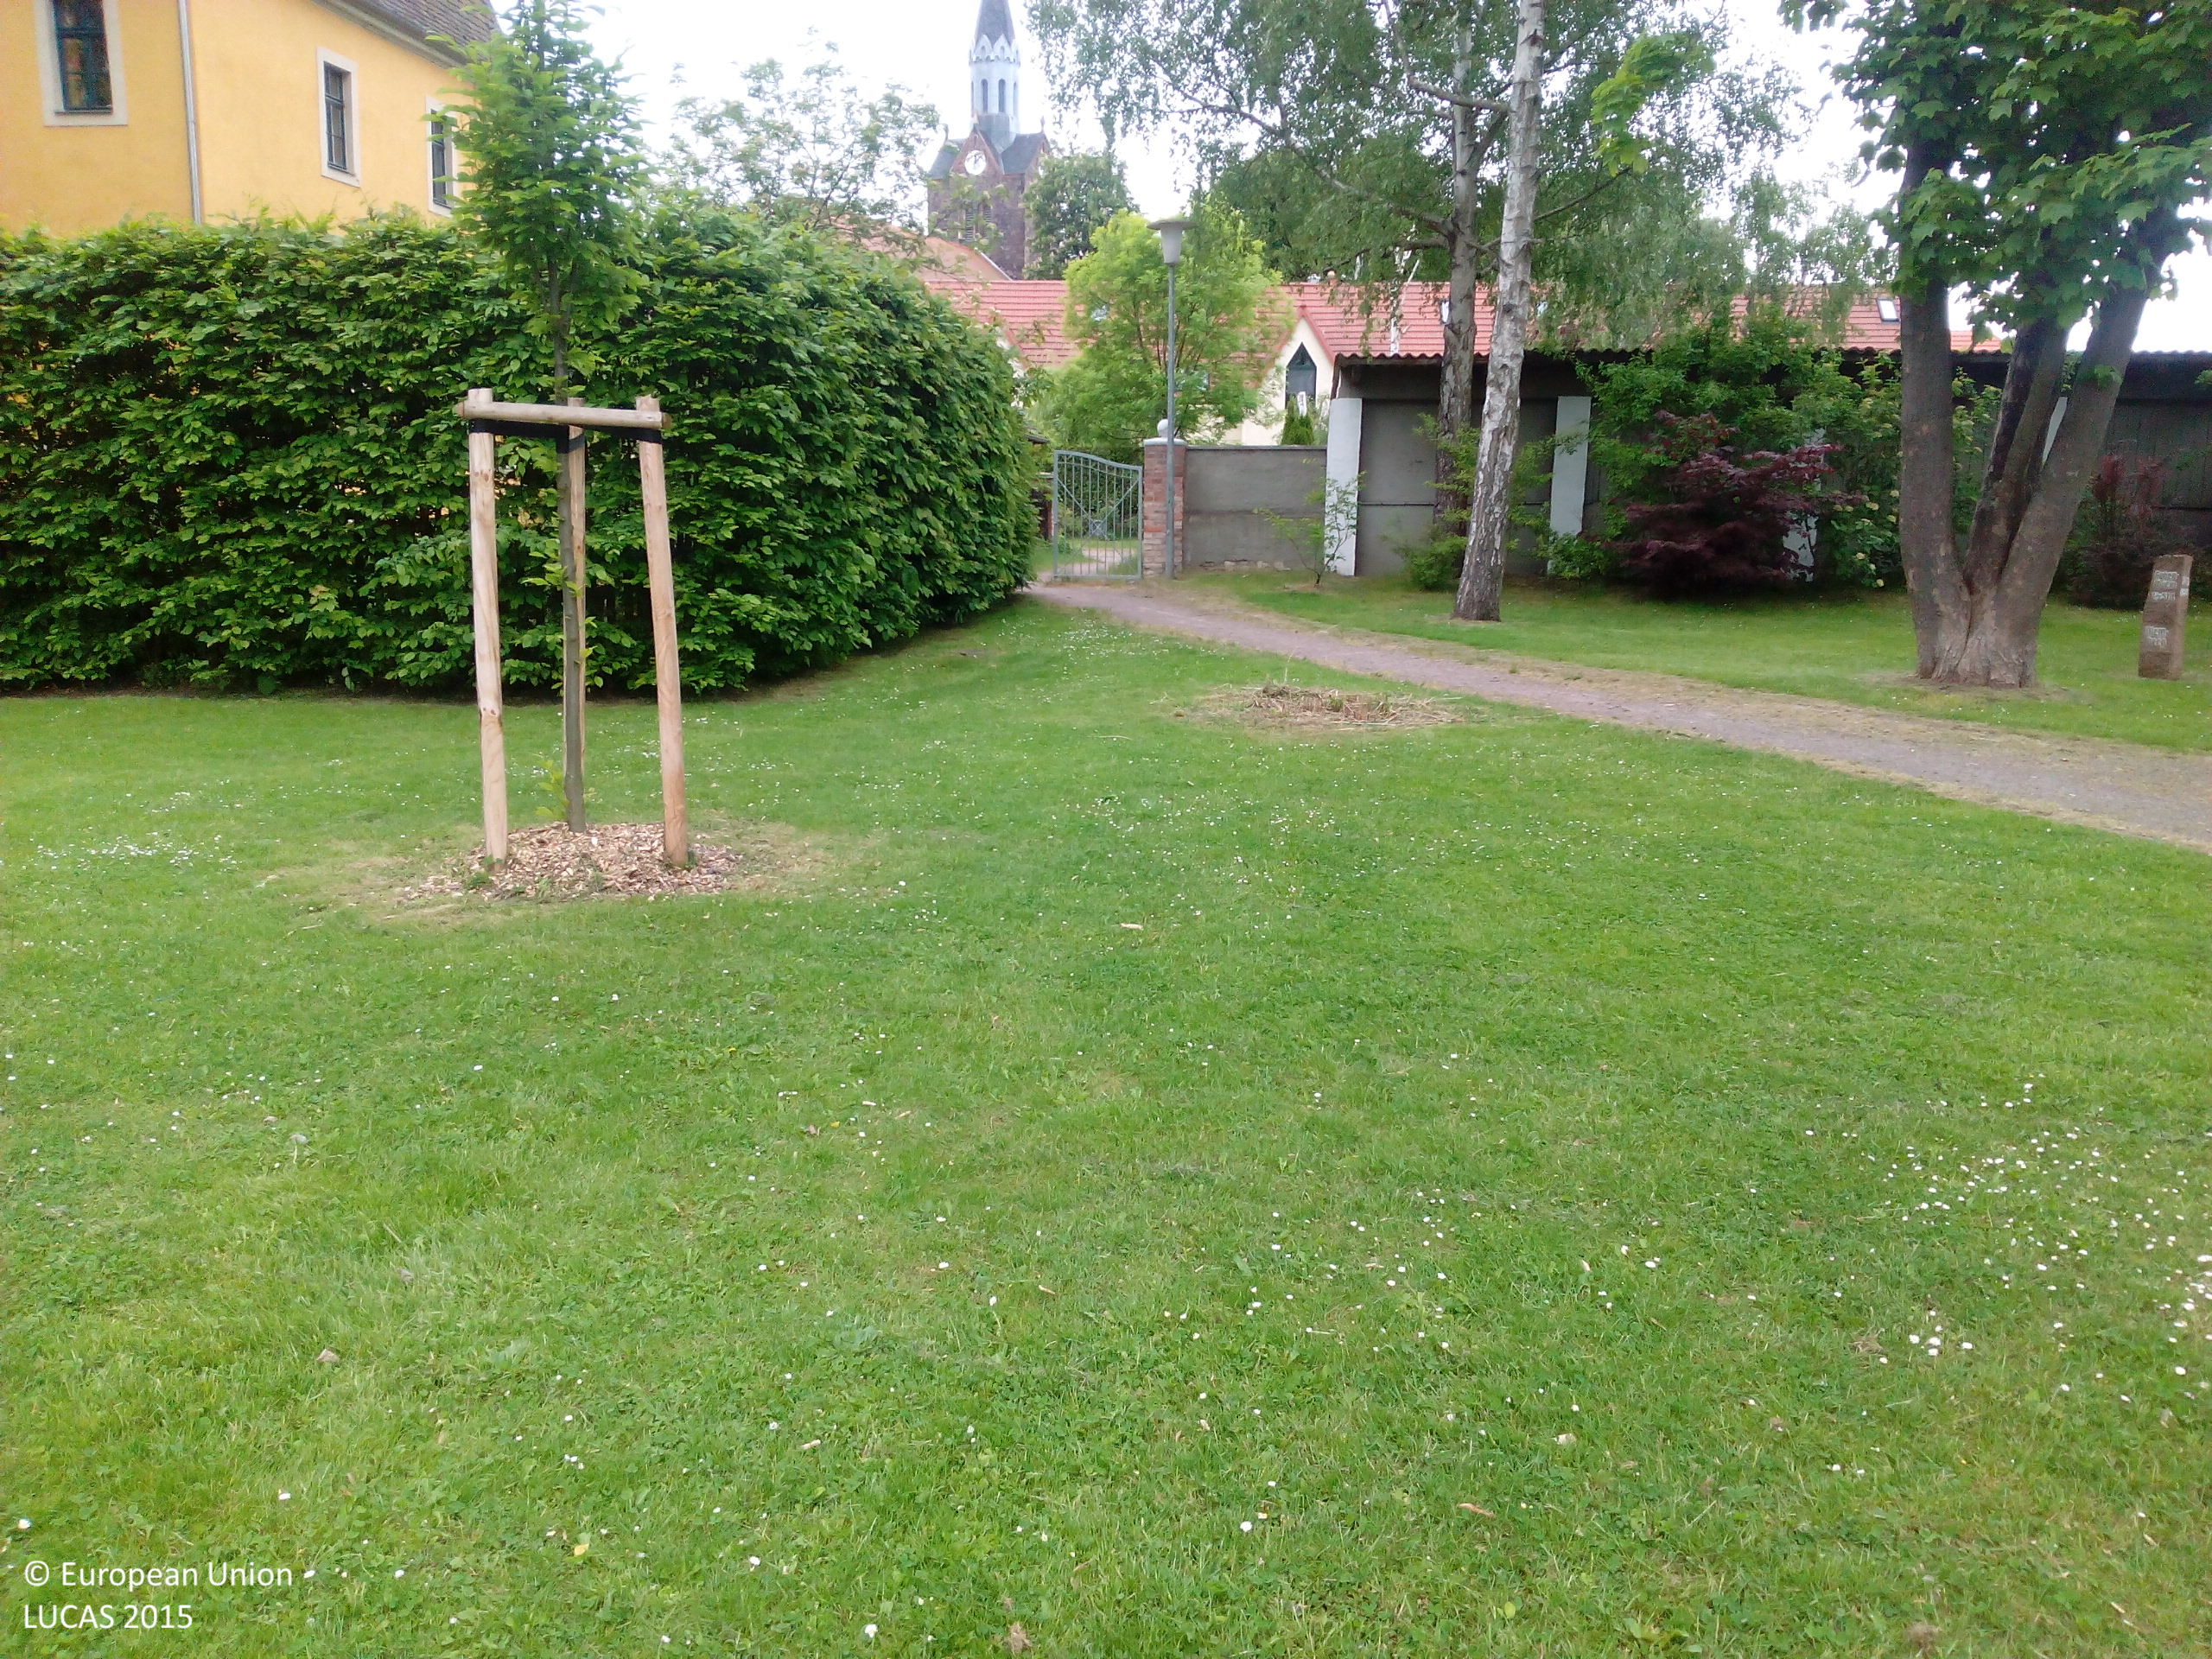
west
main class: Woodland
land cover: Broadleaved woodland
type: mesophytic deciduous forest
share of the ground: 50 - 75 %
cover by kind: broadleaved forest trees 50 %, herbaceous plants 50 %
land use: Community services
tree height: > 5 m
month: May
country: DE
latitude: 51.5499
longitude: 12.0907
